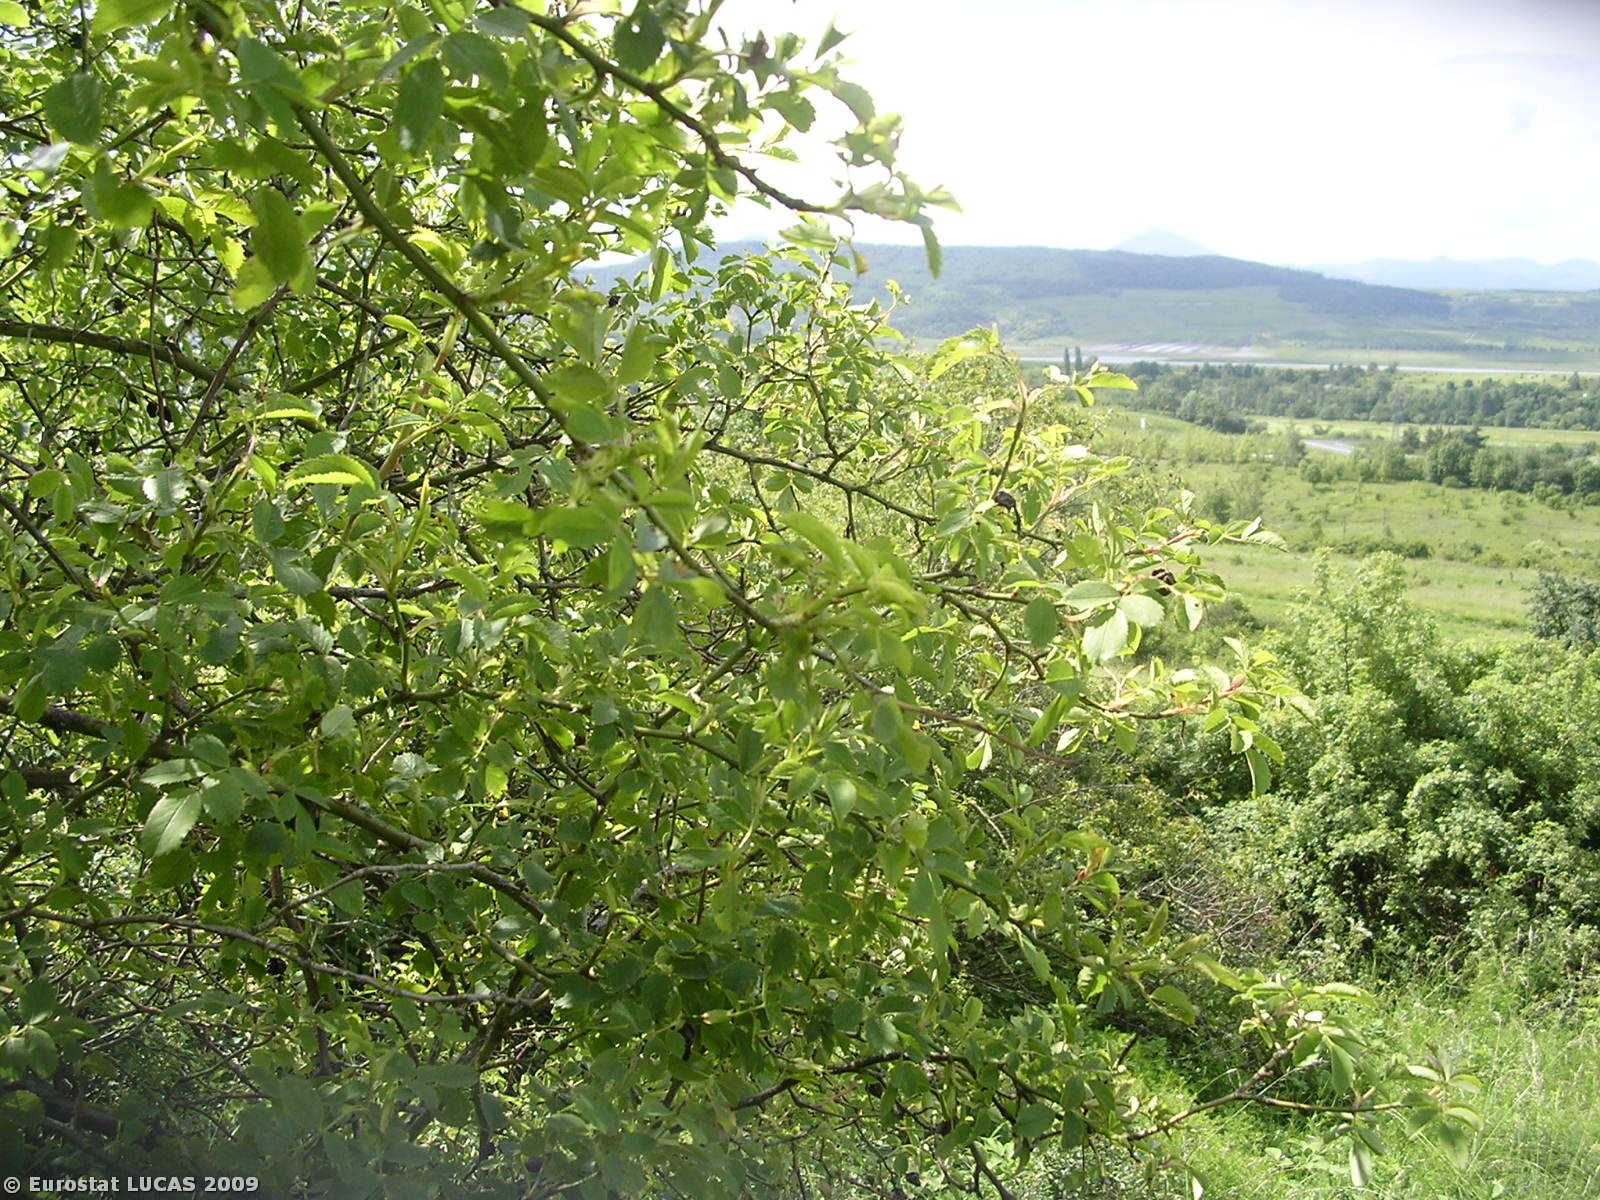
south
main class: Shrubland
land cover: Shrubland with sparse tree cover
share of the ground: 50 - 75 %
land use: Unused
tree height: > 5 m
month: June
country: CZ
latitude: 50.6730
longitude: 13.9772
